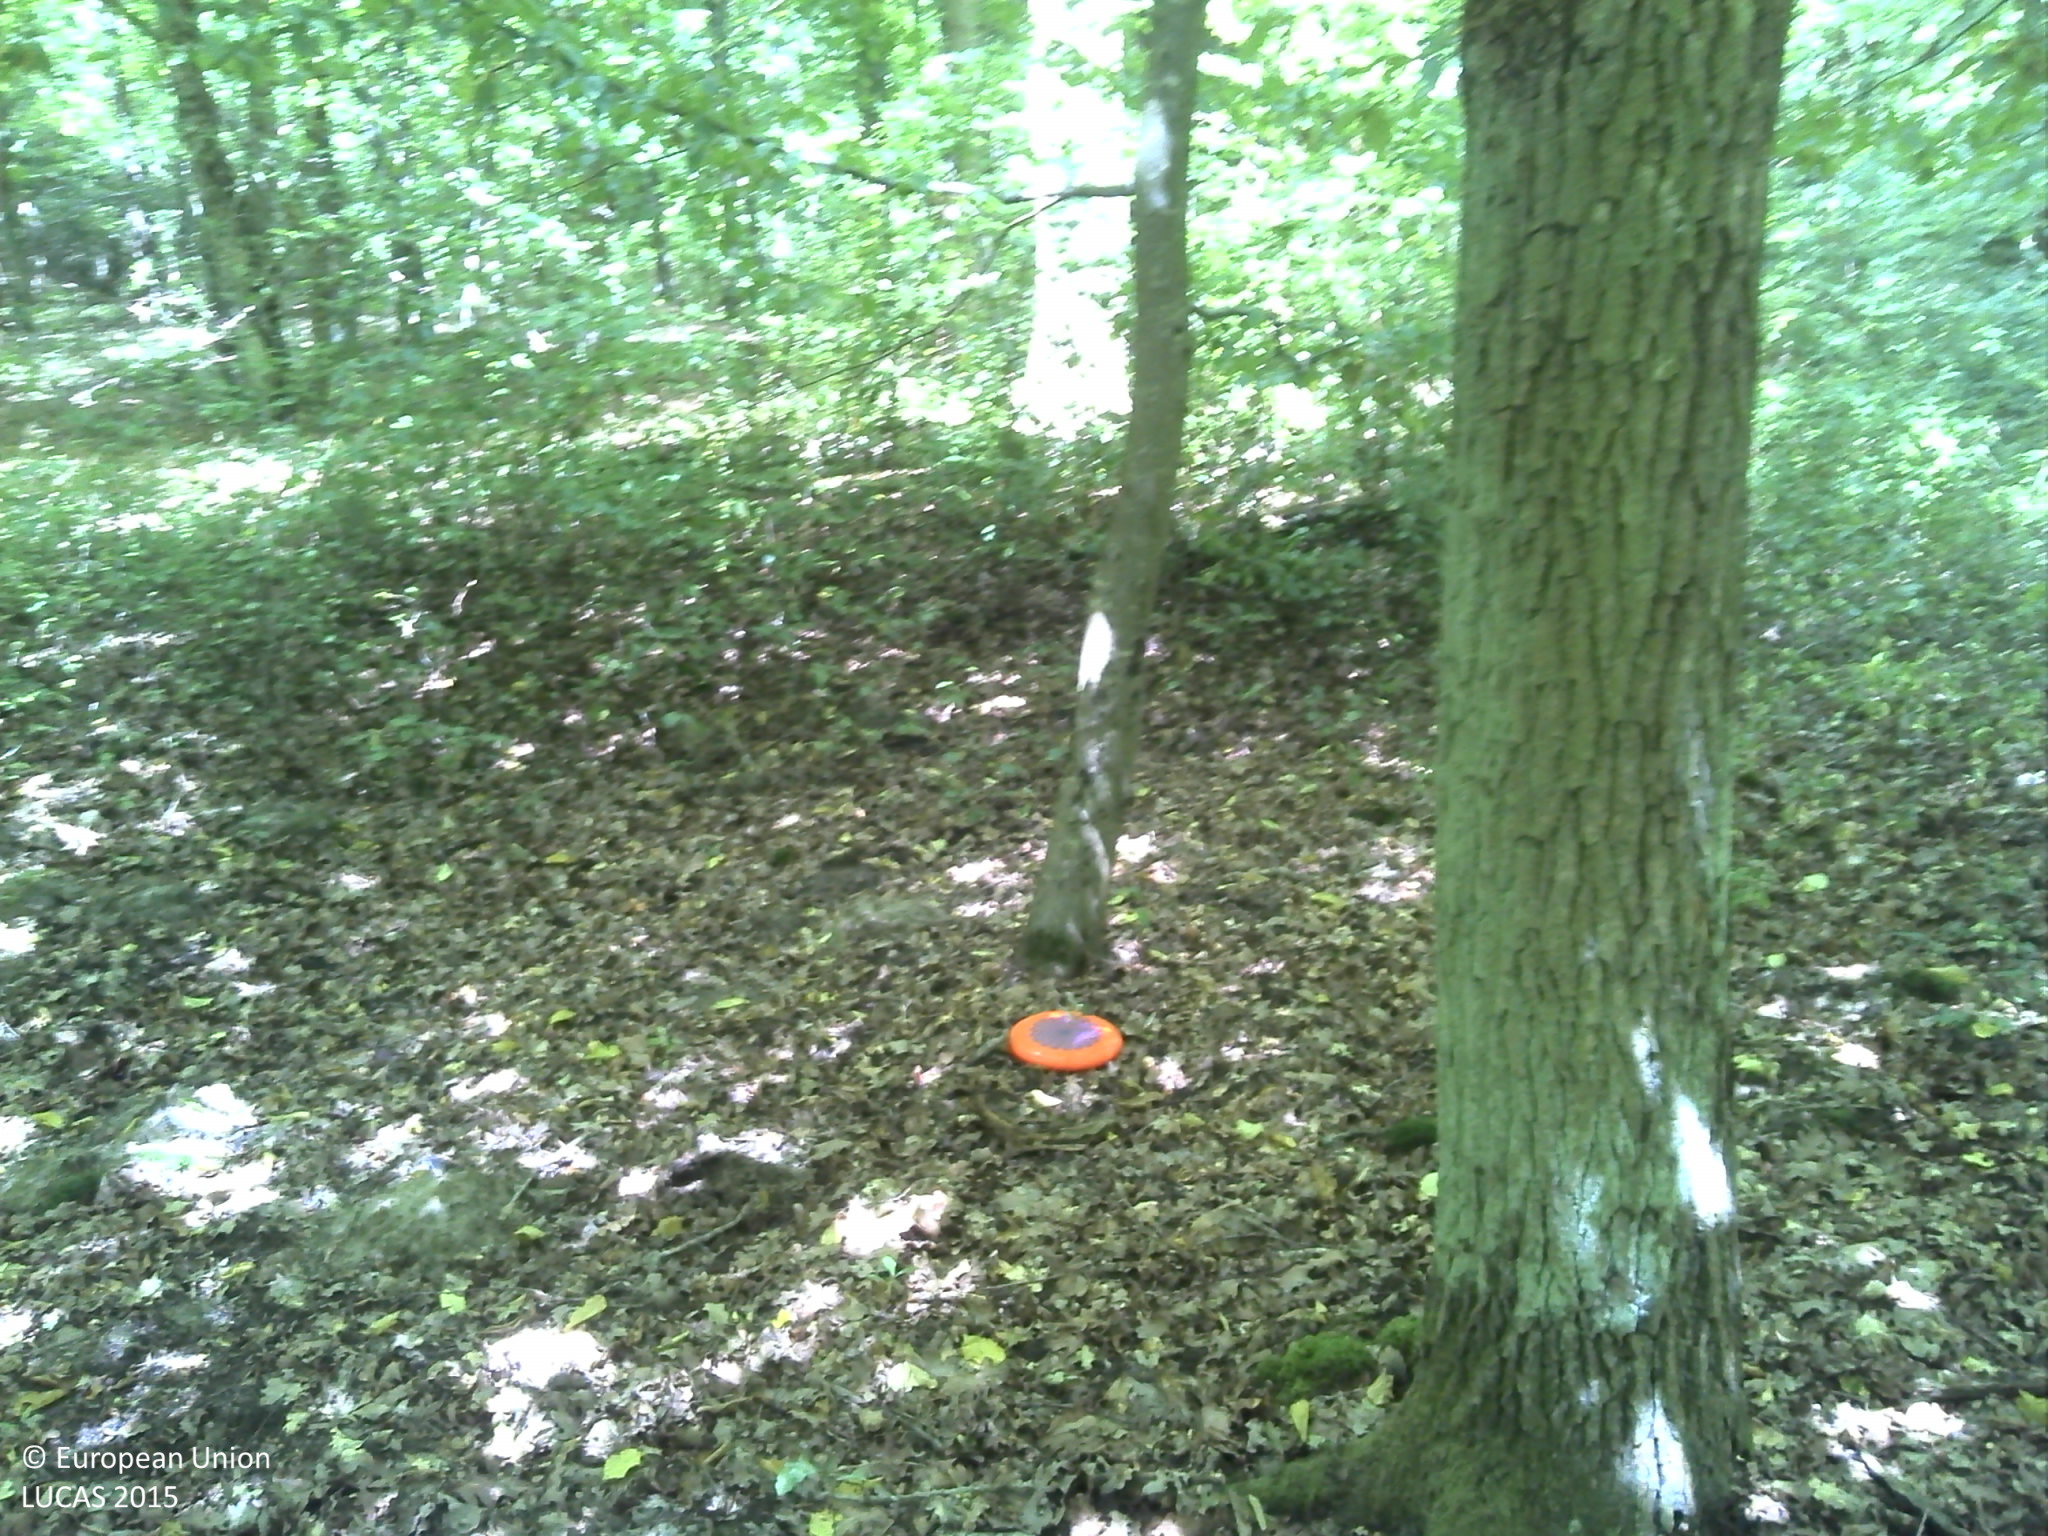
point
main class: Woodland
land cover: Broadleaved woodland
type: mesophytic deciduous forest
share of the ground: > 75 %
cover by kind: broadleaved forest trees 75 %, herbaceous plants 15 %, shrubs 10 %
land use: Forestry
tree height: > 5 m
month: July
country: FR
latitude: 45.7923
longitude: 4.1234
